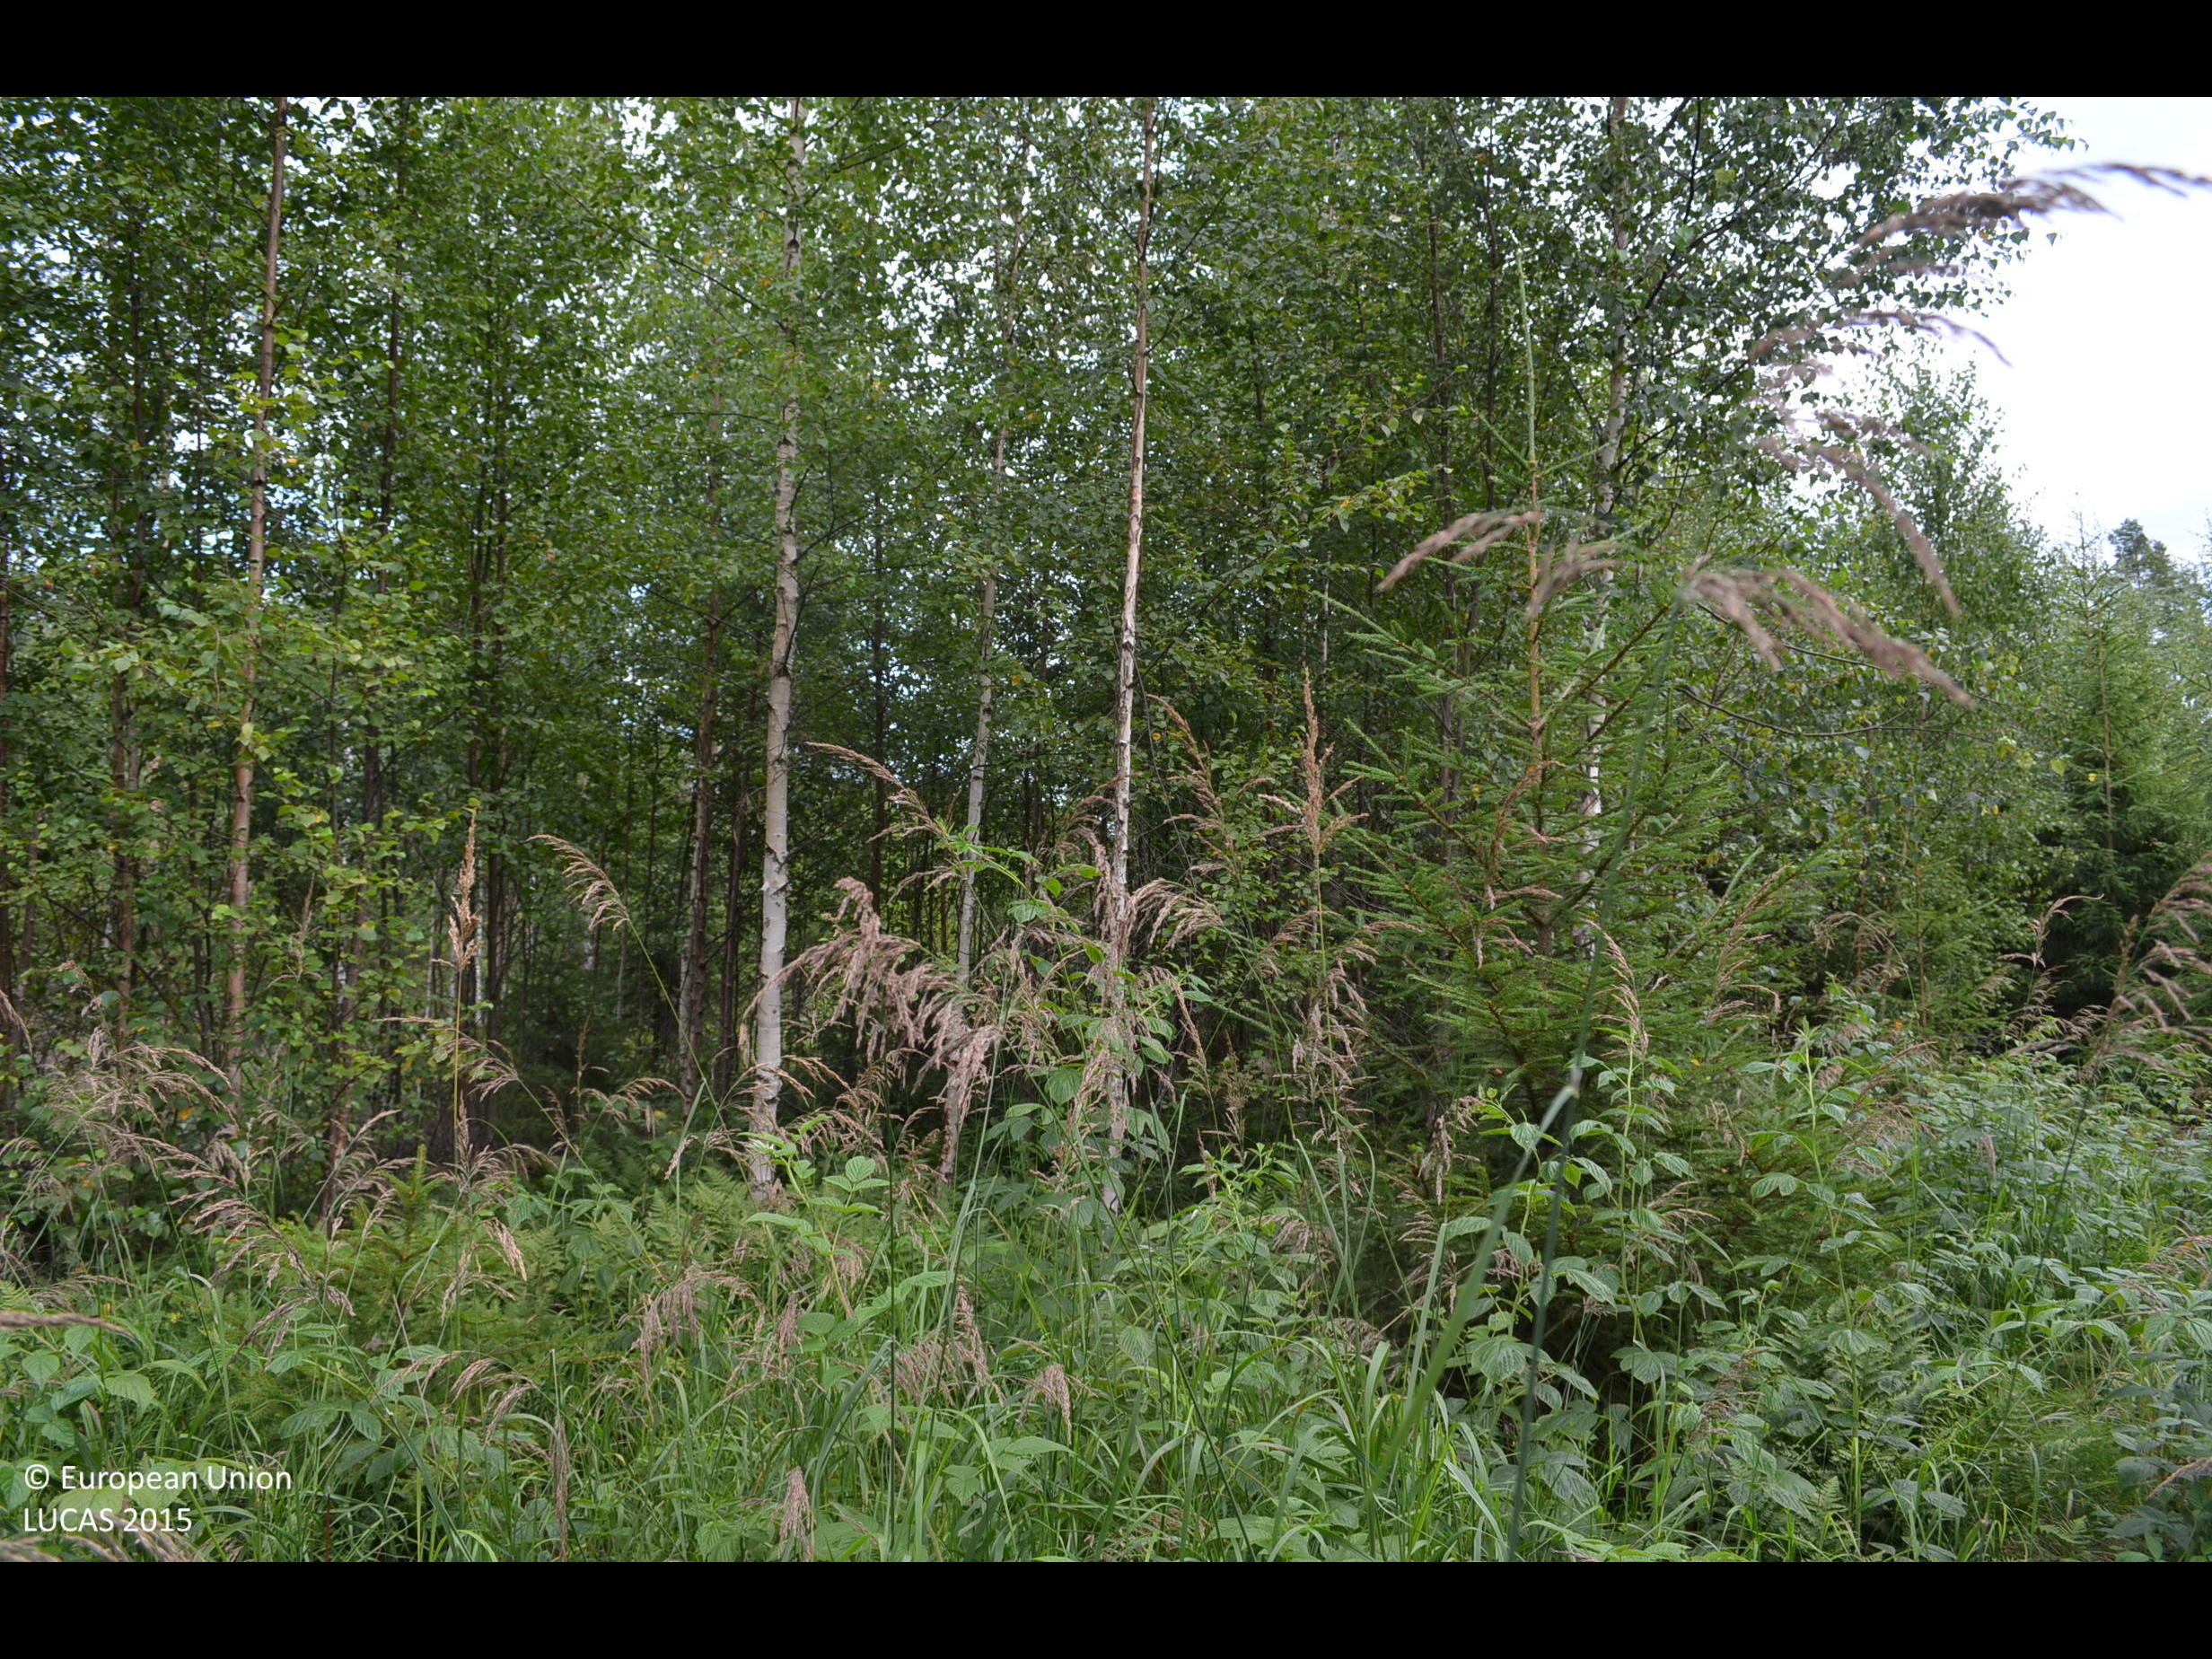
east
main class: Woodland
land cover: Broadleaved woodland
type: boreal forest
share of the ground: 50 - 75 %
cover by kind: broadleaved forest trees 60 %, shrubs 25 %, herbaceous plants 10 %, coniferous forest trees 5 %
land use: Forestry
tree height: < 5 m
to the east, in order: Broadleaved woodland; Pine dominated mixed woodland; Spruce dominated mixed woodland; Ditches and canals; Spruce dominated mixed woodland; Spruce dominated coniferous woodland; Ditches and canals; Spruce dominated coniferous woodland; Pine dominated mixed woodland
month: August
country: FI
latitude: 61.5735
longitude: 23.1607
